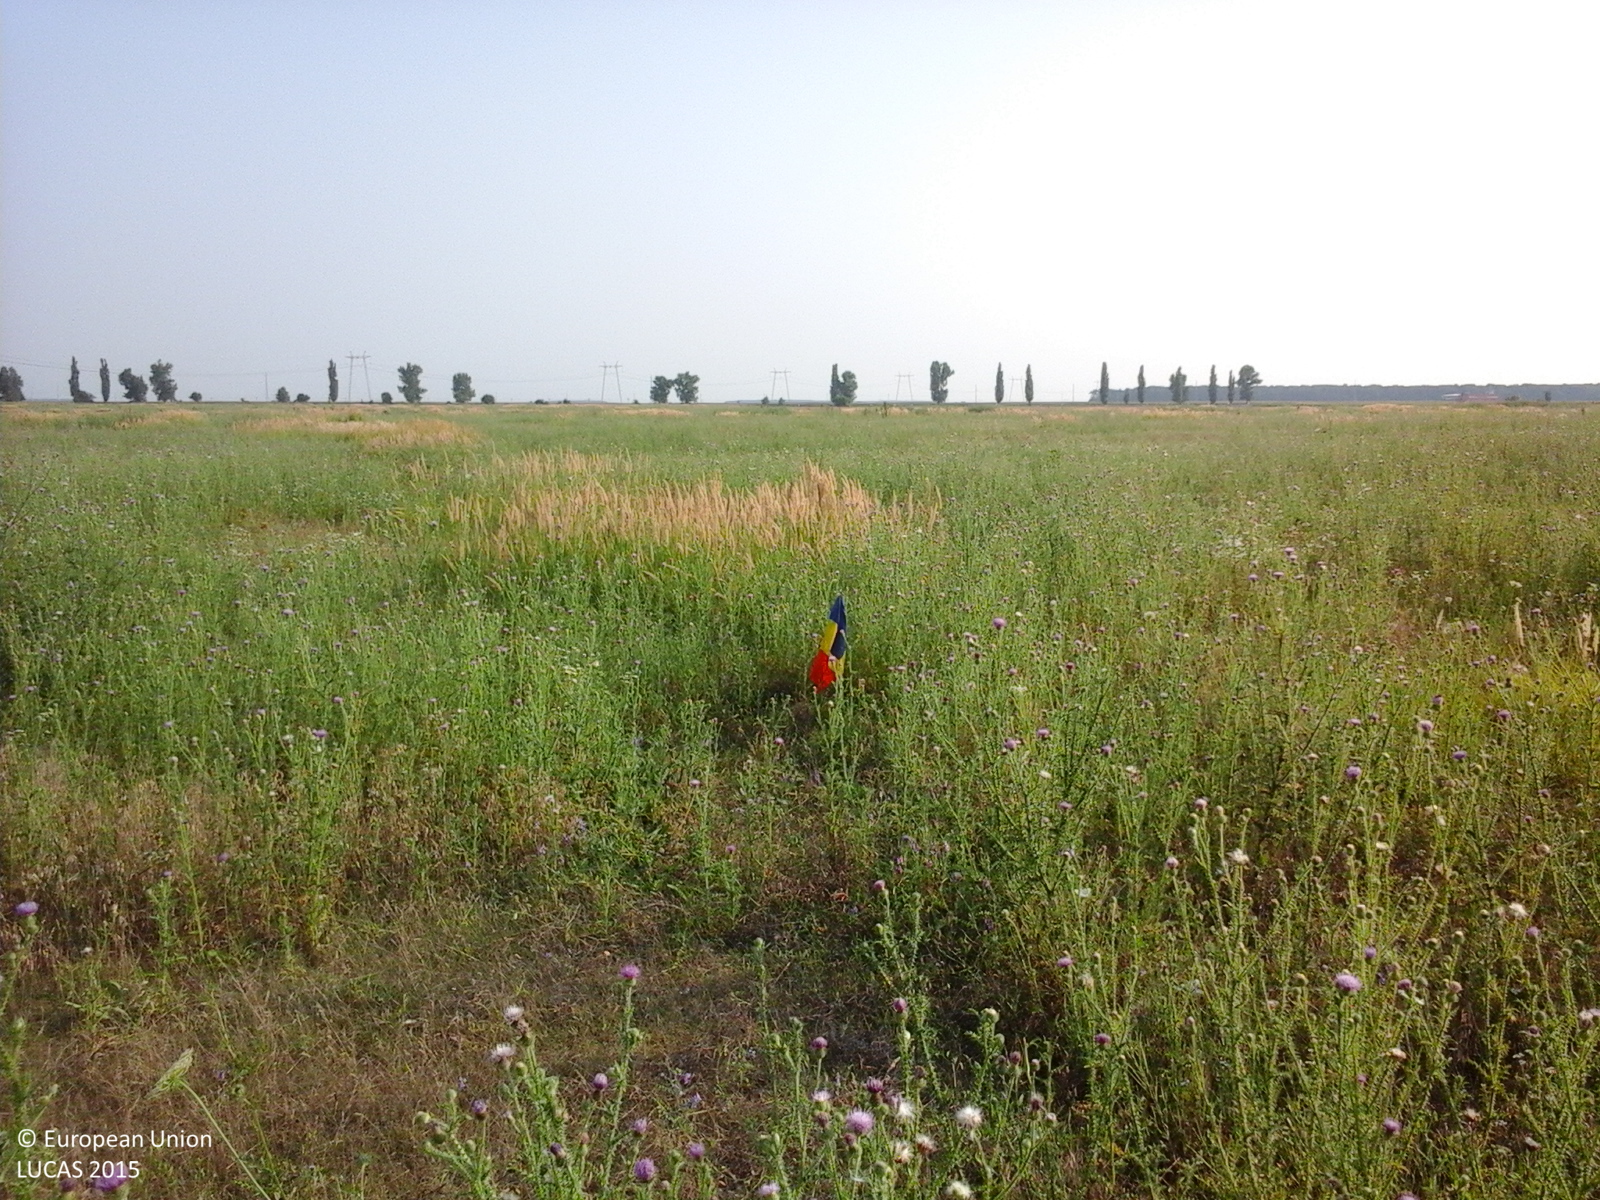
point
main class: Grassland
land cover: Spontaneously vegetated surfaces
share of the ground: > 75 %
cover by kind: herbaceous plants 100 %
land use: Fallow land
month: July
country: RO
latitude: 44.4753
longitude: 26.4704
